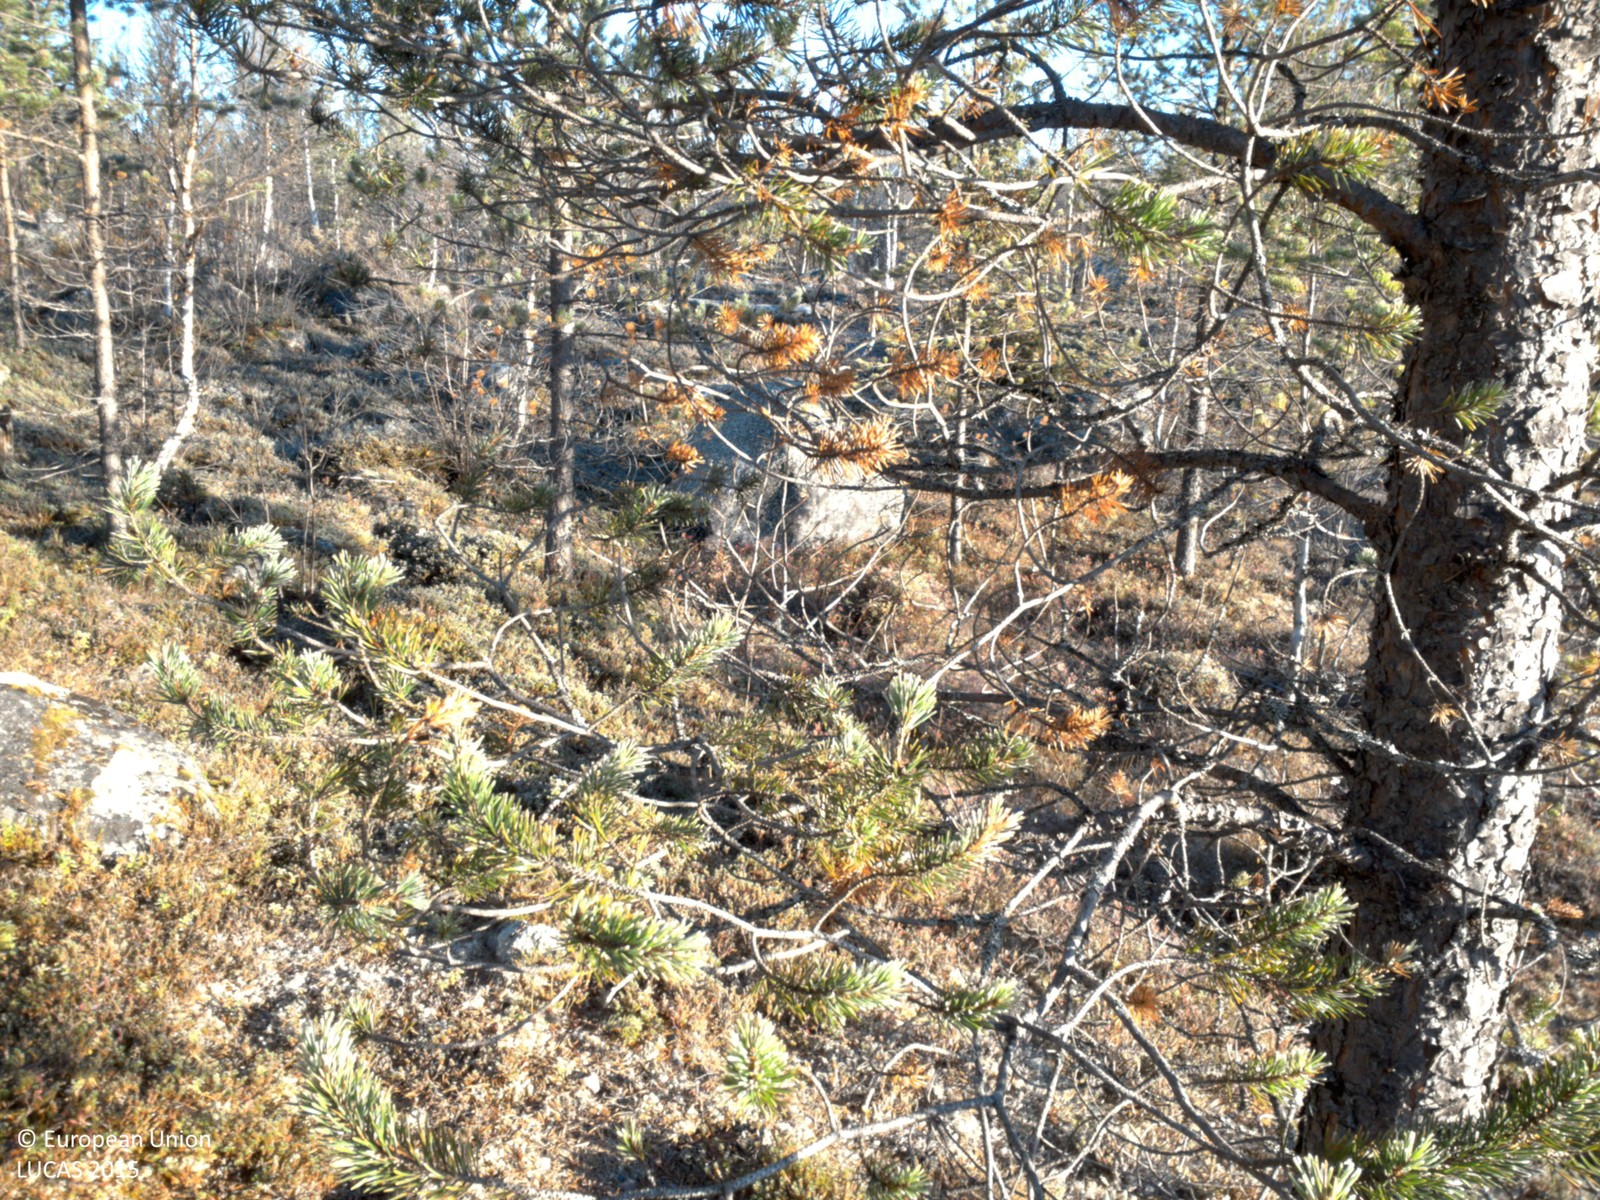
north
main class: Woodland
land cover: Pine dominated coniferous woodland
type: mire and swamp forests
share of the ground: 25 - 50 %
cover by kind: coniferous forest trees 50 %, shrubs 25 %, herbaceous plants 15 %, lichens and mosses 10 %
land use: Forestry
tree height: > 5 m
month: October
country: SE
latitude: 64.7131
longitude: 17.8340
